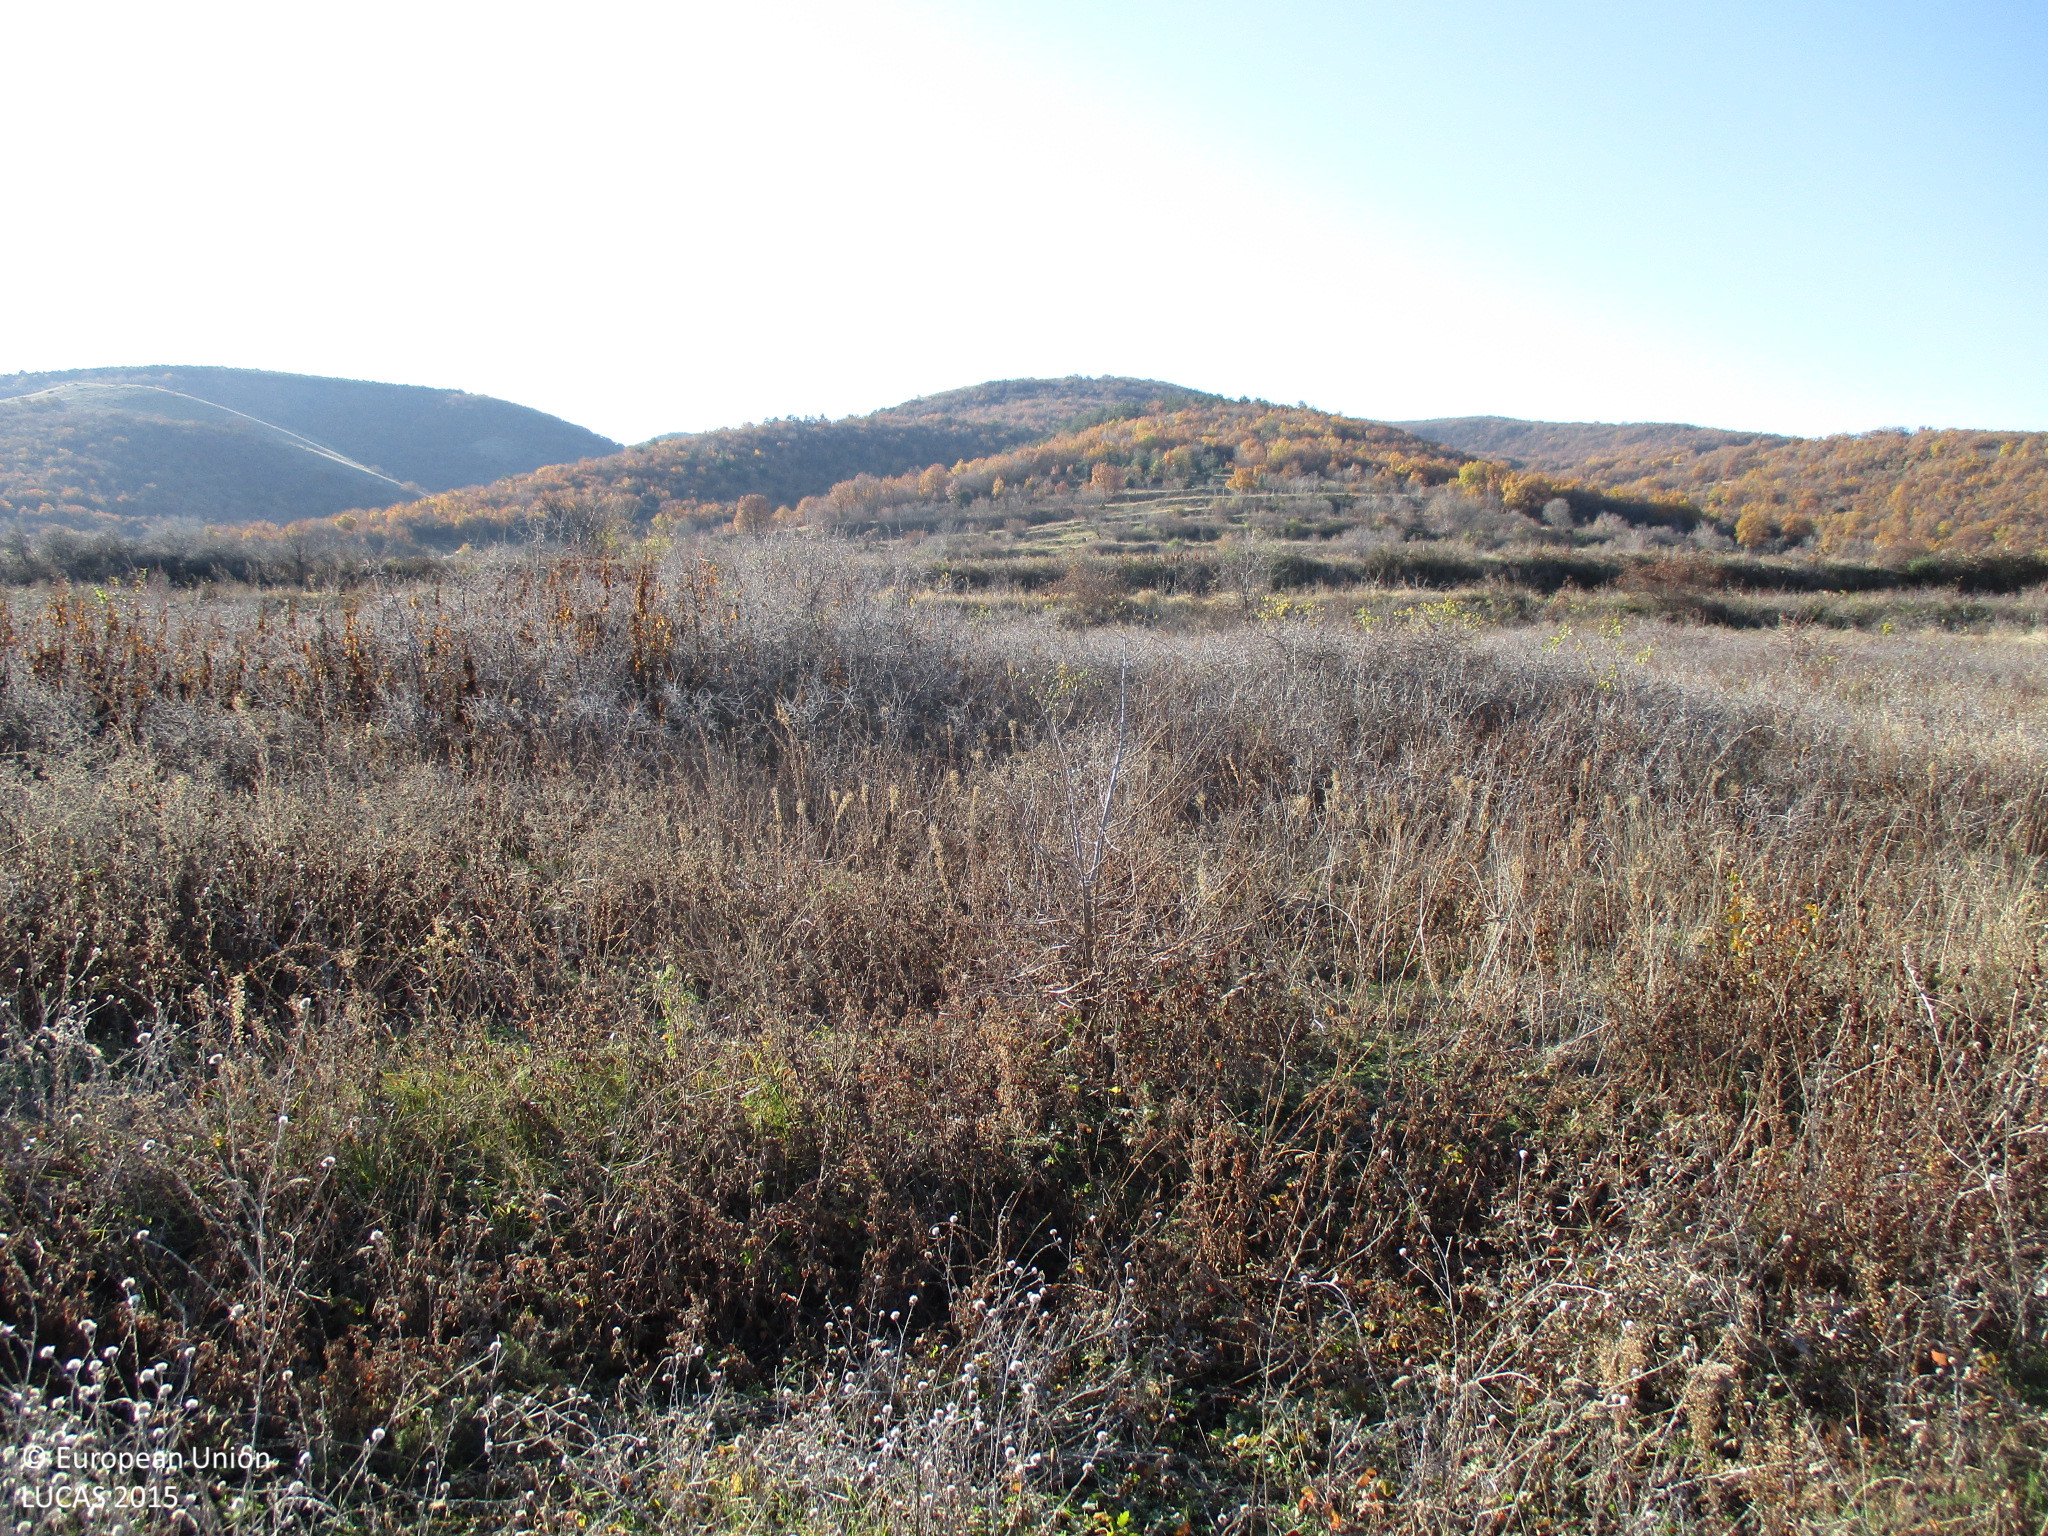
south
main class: Shrubland
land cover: Shrubland without tree cover
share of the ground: > 75 %
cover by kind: shrubs 70 %, herbaceous plants 30 %
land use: Semi-natural and natural areas not in use
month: December
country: BG
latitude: 42.0717
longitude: 24.6860
